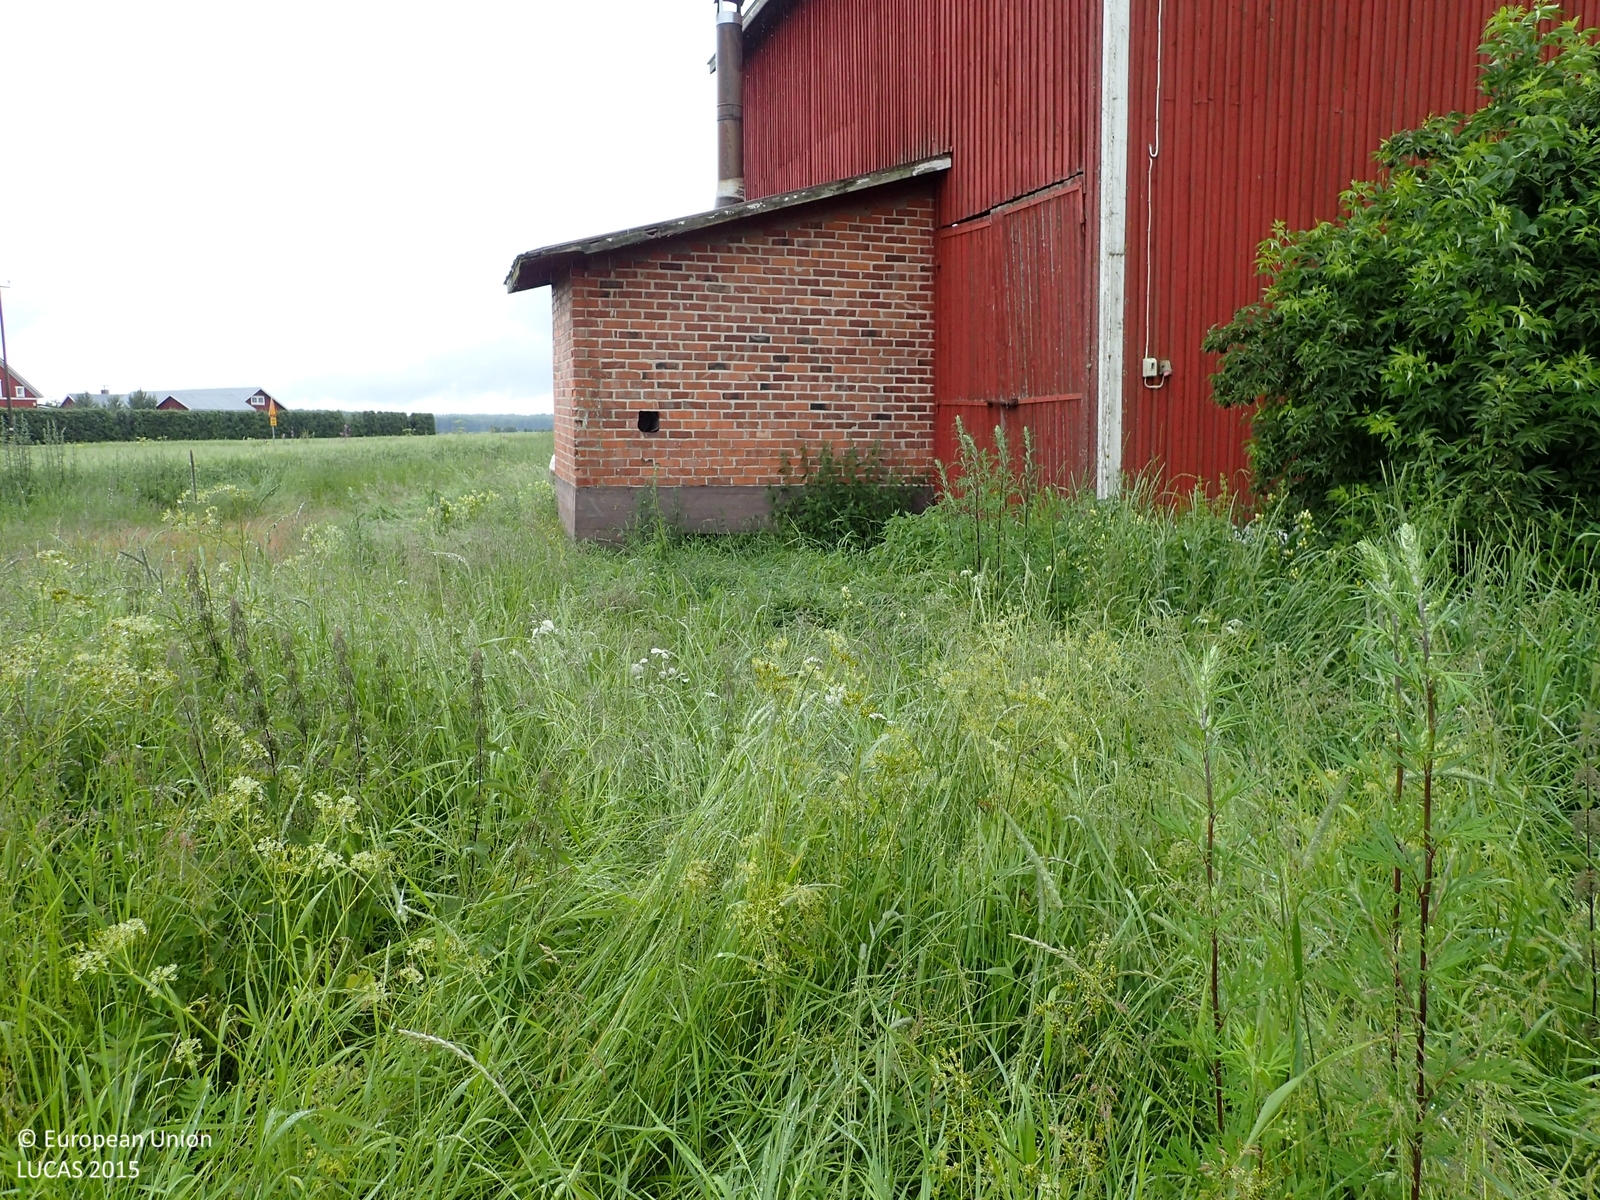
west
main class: Cropland
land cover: Barley
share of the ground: > 75 %
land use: Agriculture (excluding fallow land and kitchen gardens)
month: July
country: FI
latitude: 62.9970
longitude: 21.9088
